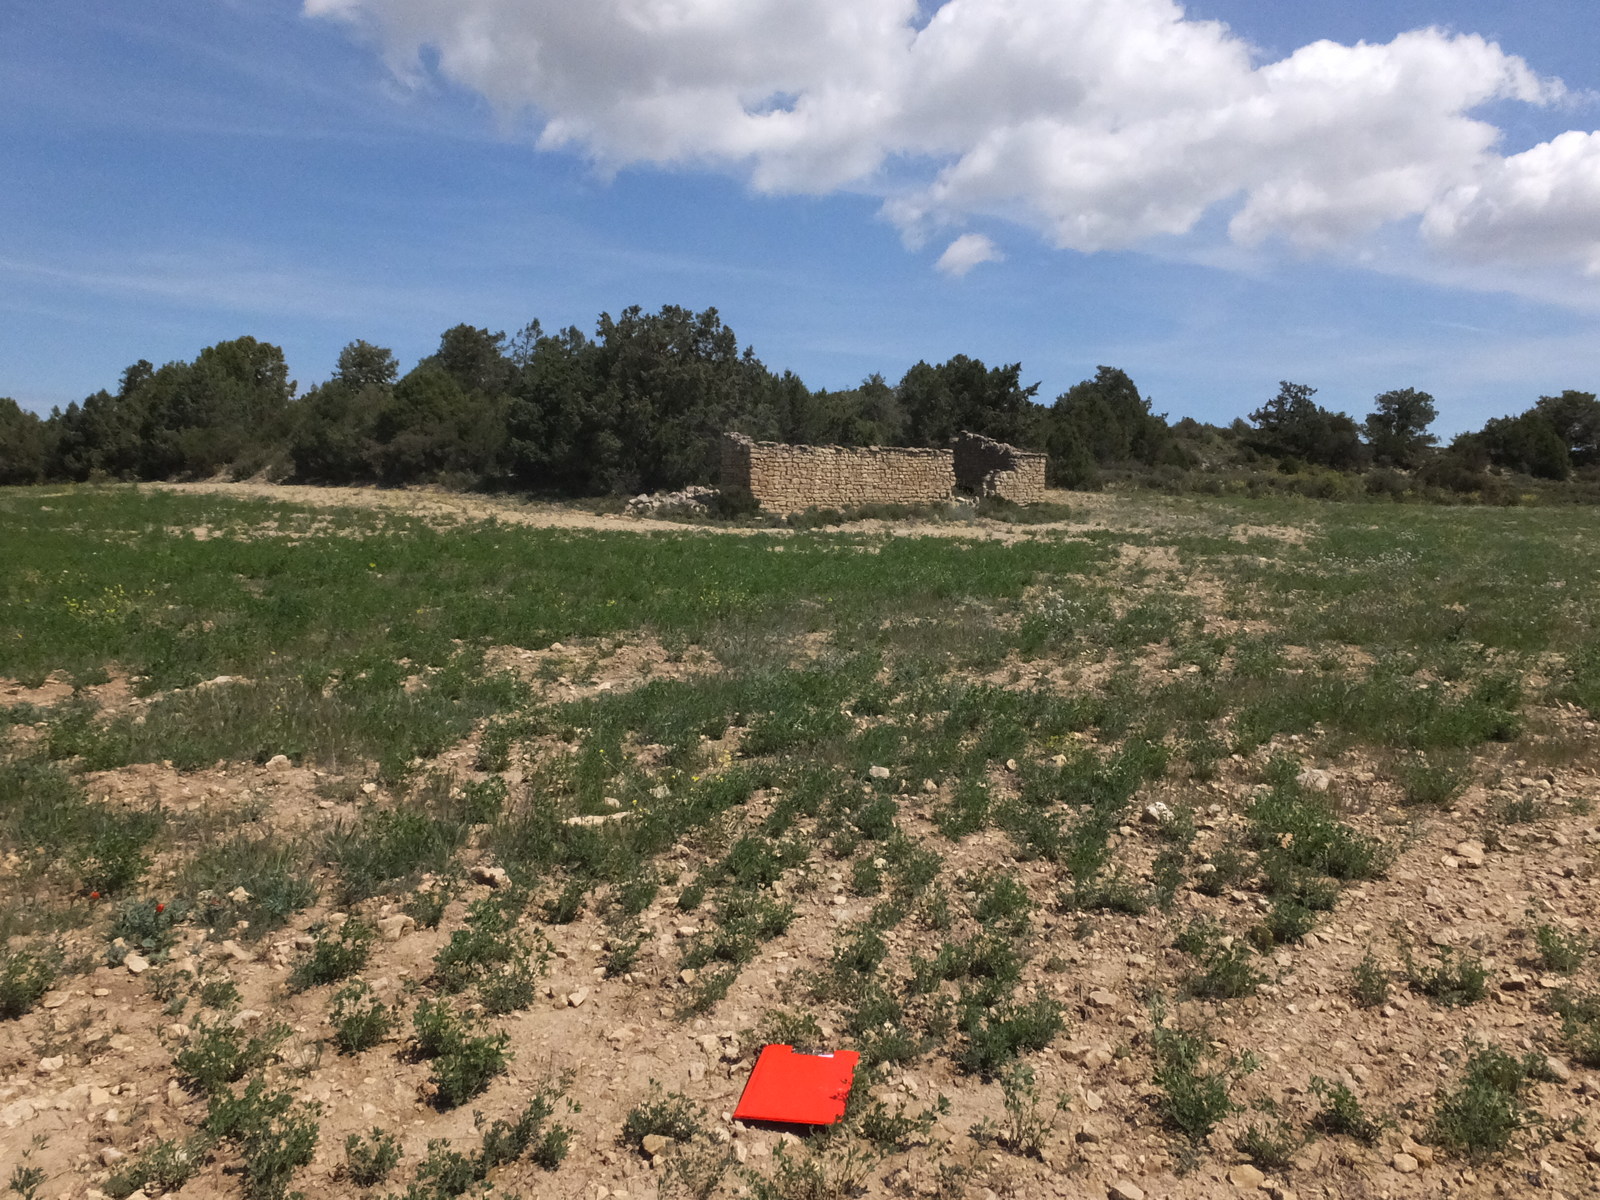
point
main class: Cropland
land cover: Lucerne
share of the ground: > 75 %
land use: Agriculture (excluding fallow land and kitchen gardens)
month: April
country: ES
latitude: 41.6511
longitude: -0.3323
